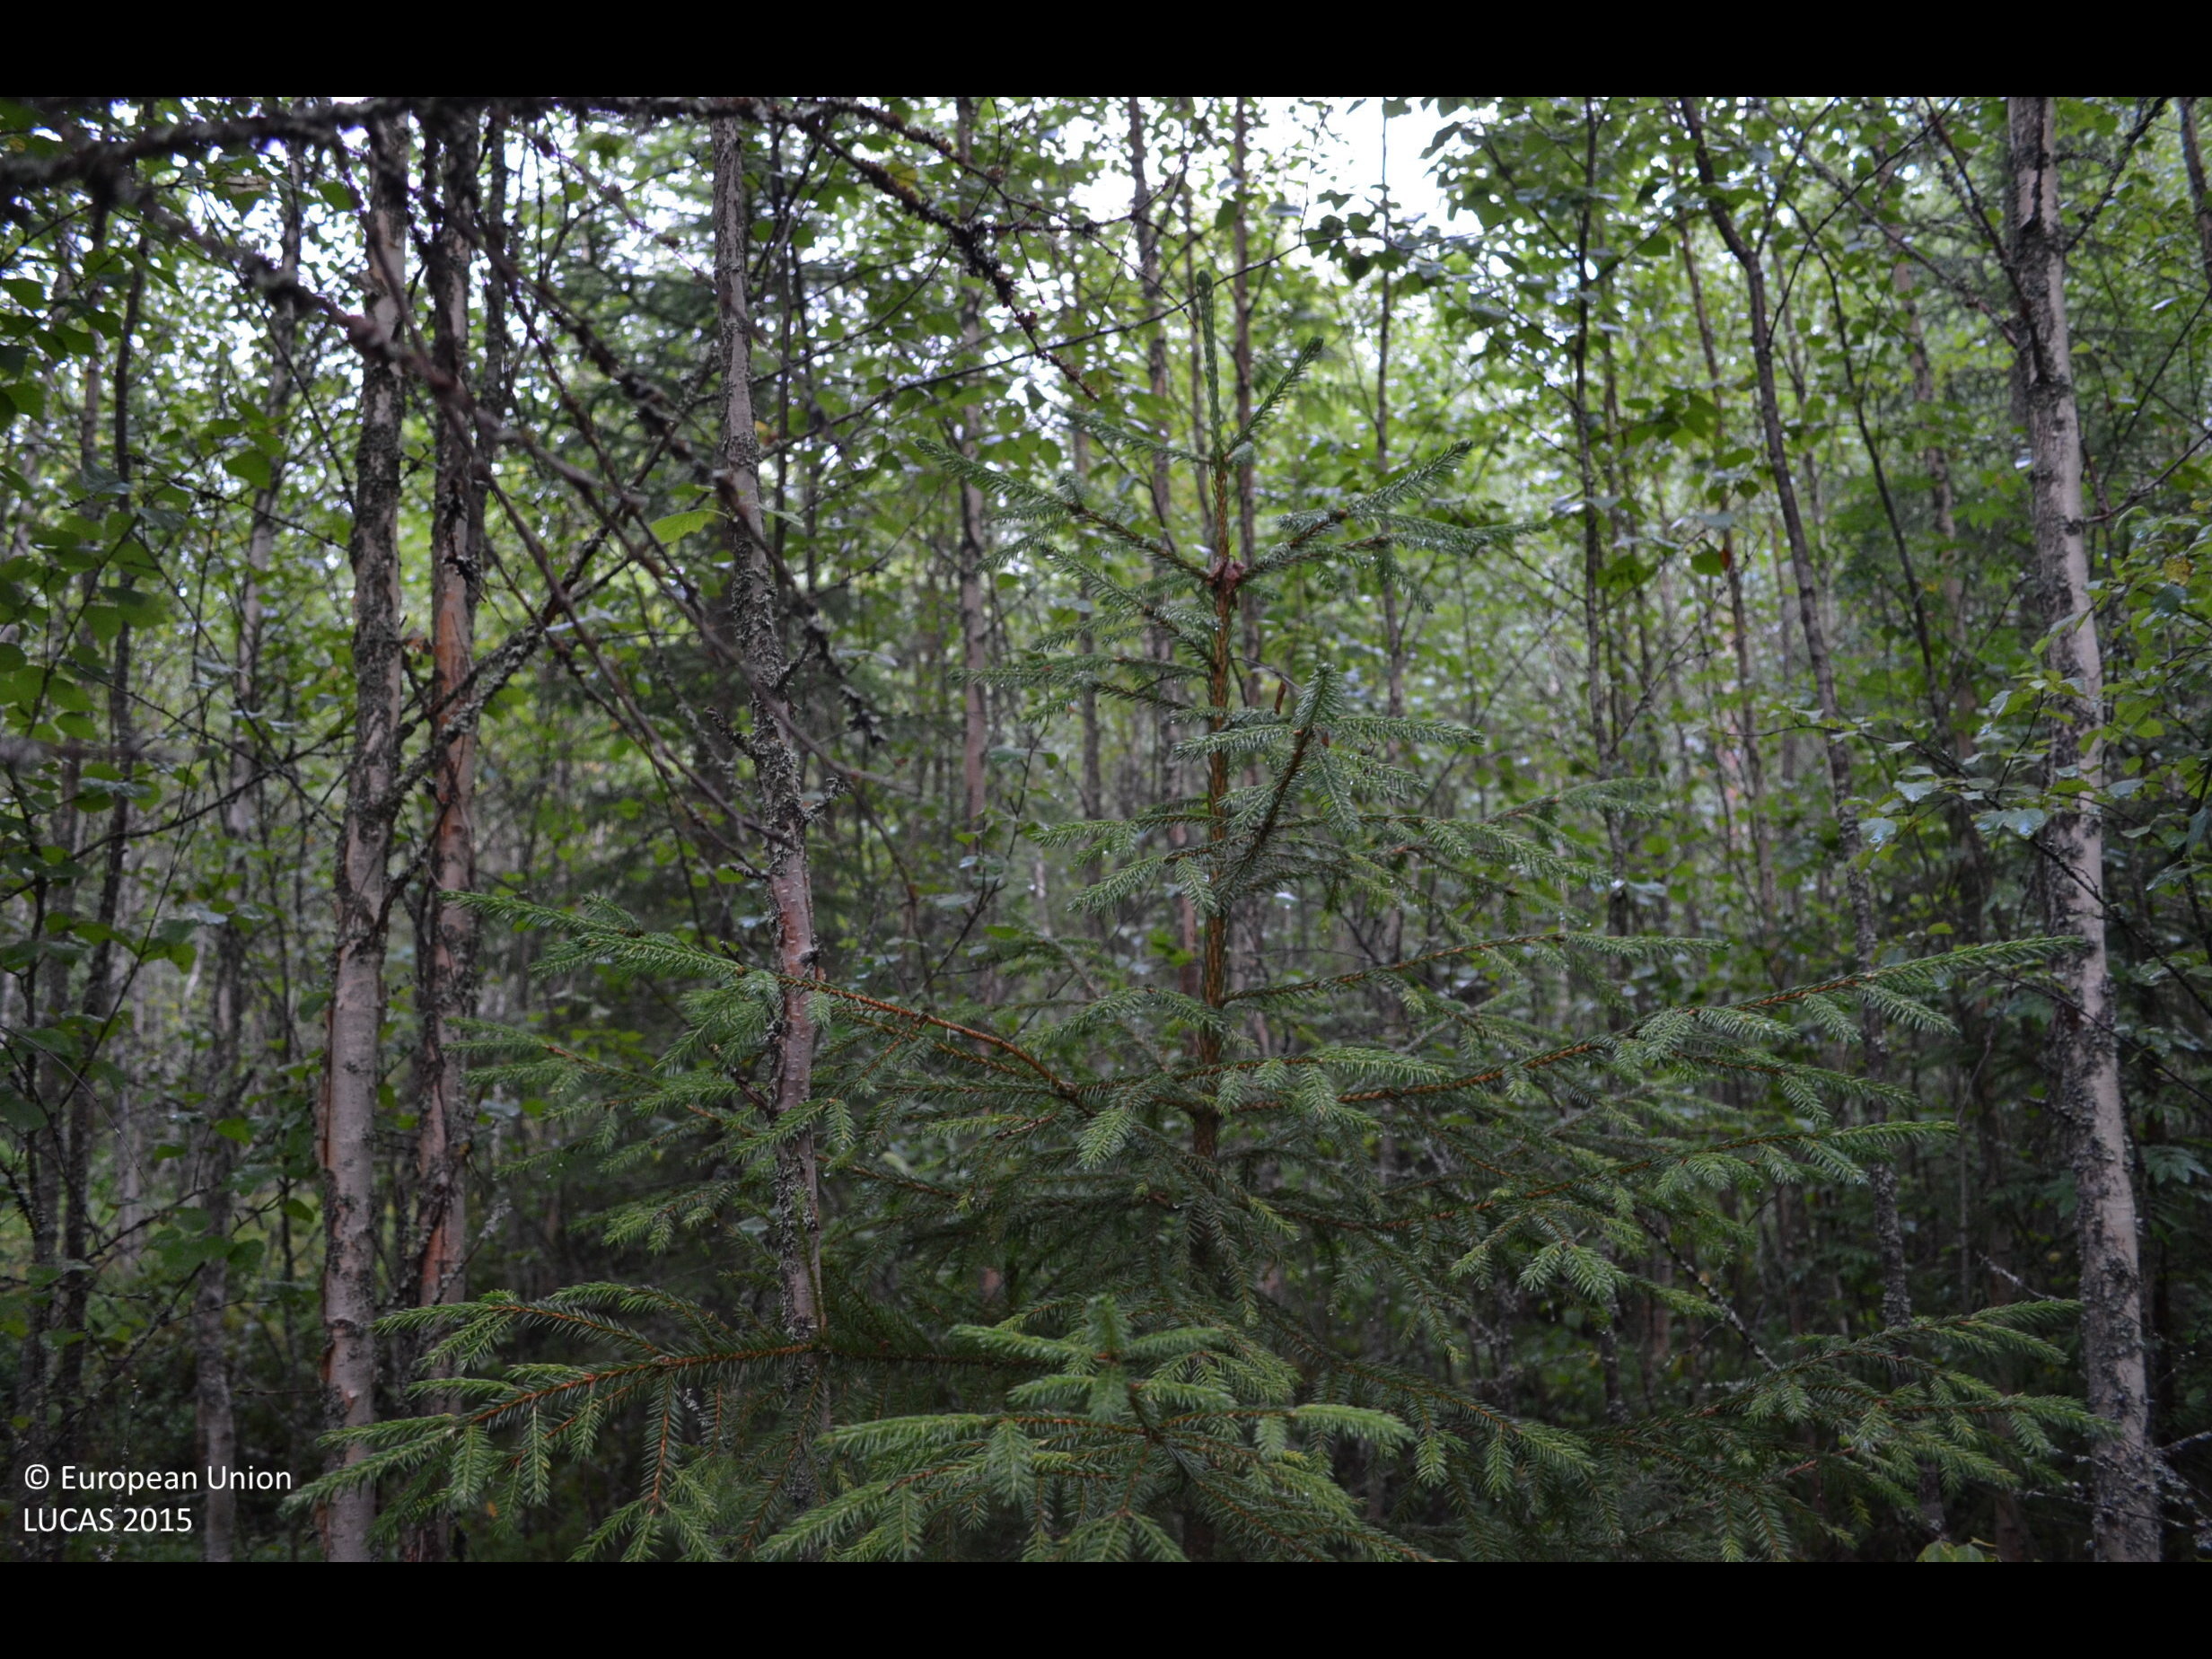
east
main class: Woodland
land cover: Broadleaved woodland
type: boreal forest
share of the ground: > 75 %
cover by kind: broadleaved forest trees 75 %, coniferous forest trees 20 %, herbaceous plants 5 %
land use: Forestry
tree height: > 5 m
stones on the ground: < 10 %
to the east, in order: Broadleaved woodland; Other mixed woodland; Ditches and canals; Spruce dominated mixed woodland; Ditches and canals; Spruce dominated coniferous woodland; Ditches and canals; Spruce dominated mixed woodland; Other mixed woodland; Ditches and canals; Grass margins; Tracks; Grass margins; Ditches and canals; Pine dominated coniferous woodland
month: July
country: FI
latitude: 61.8988
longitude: 24.1907
